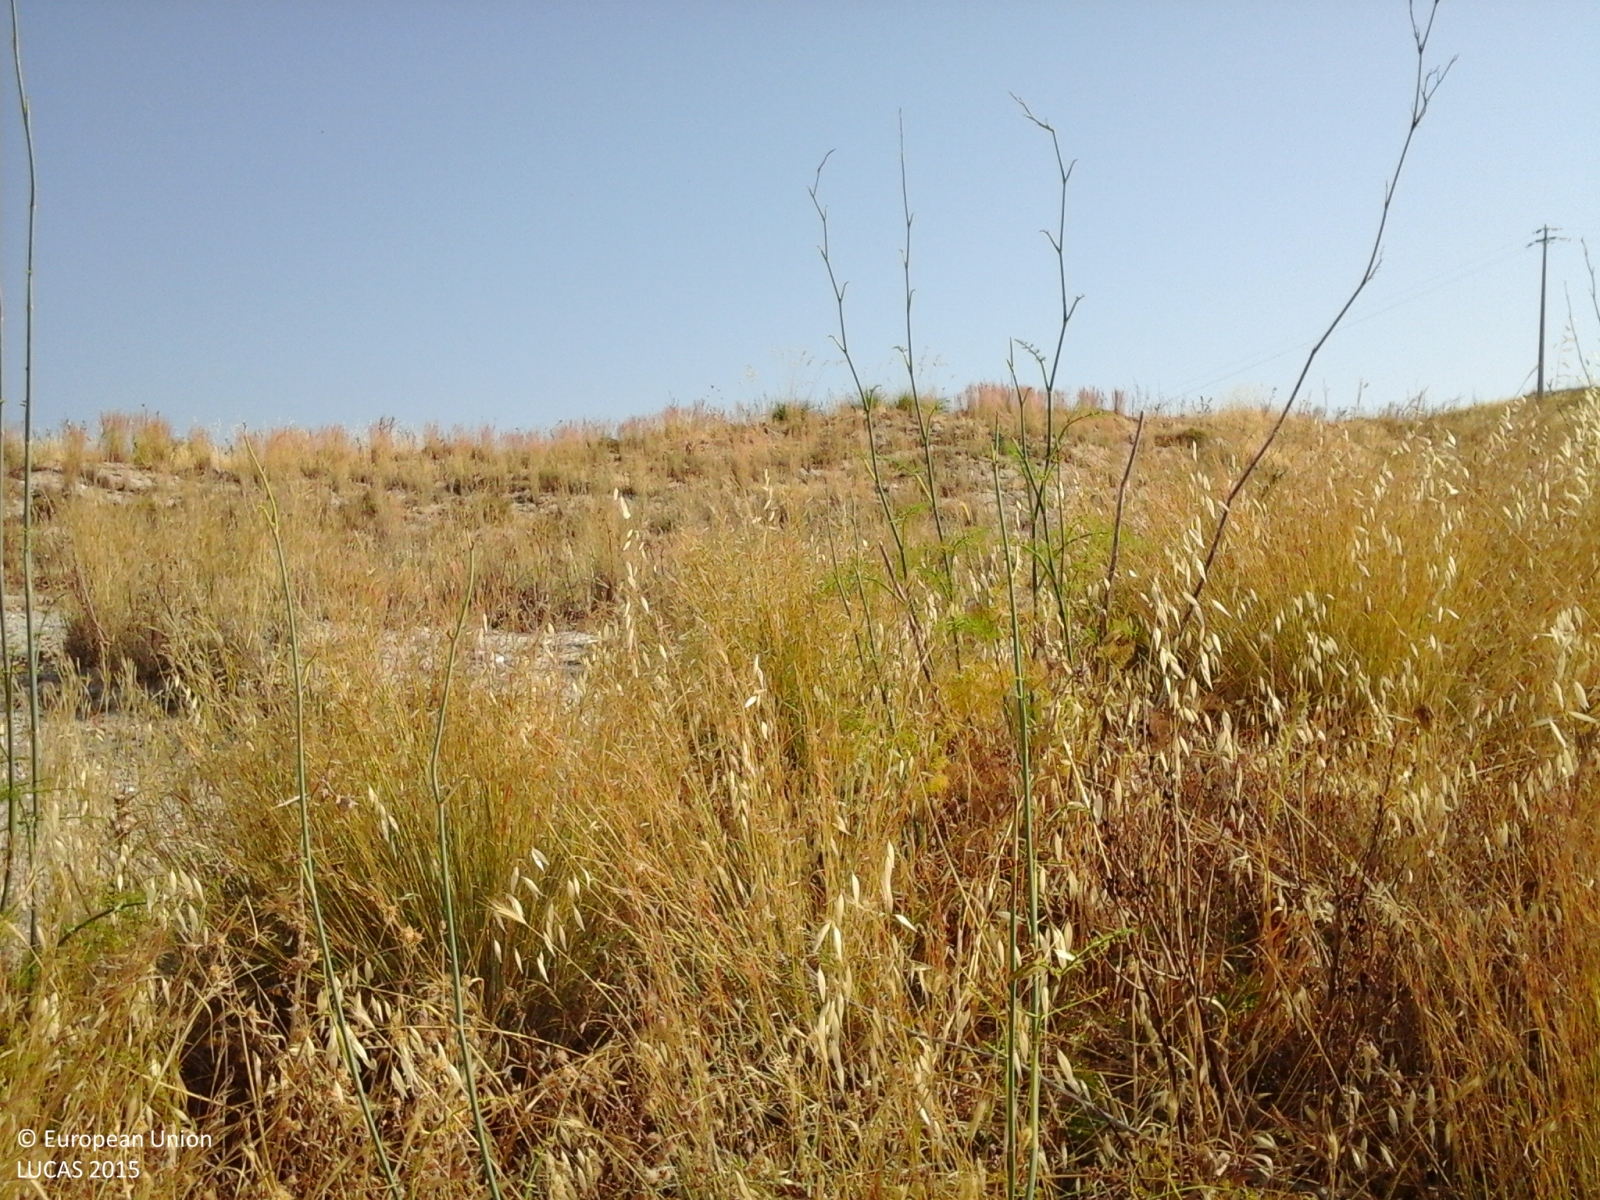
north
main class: Grassland
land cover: Grassland without tree/shrub cover
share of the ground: > 75 %
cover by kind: herbaceous plants 100 %
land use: Semi-natural and natural areas not in use
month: July
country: IT
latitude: 37.3264
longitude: 13.7964
